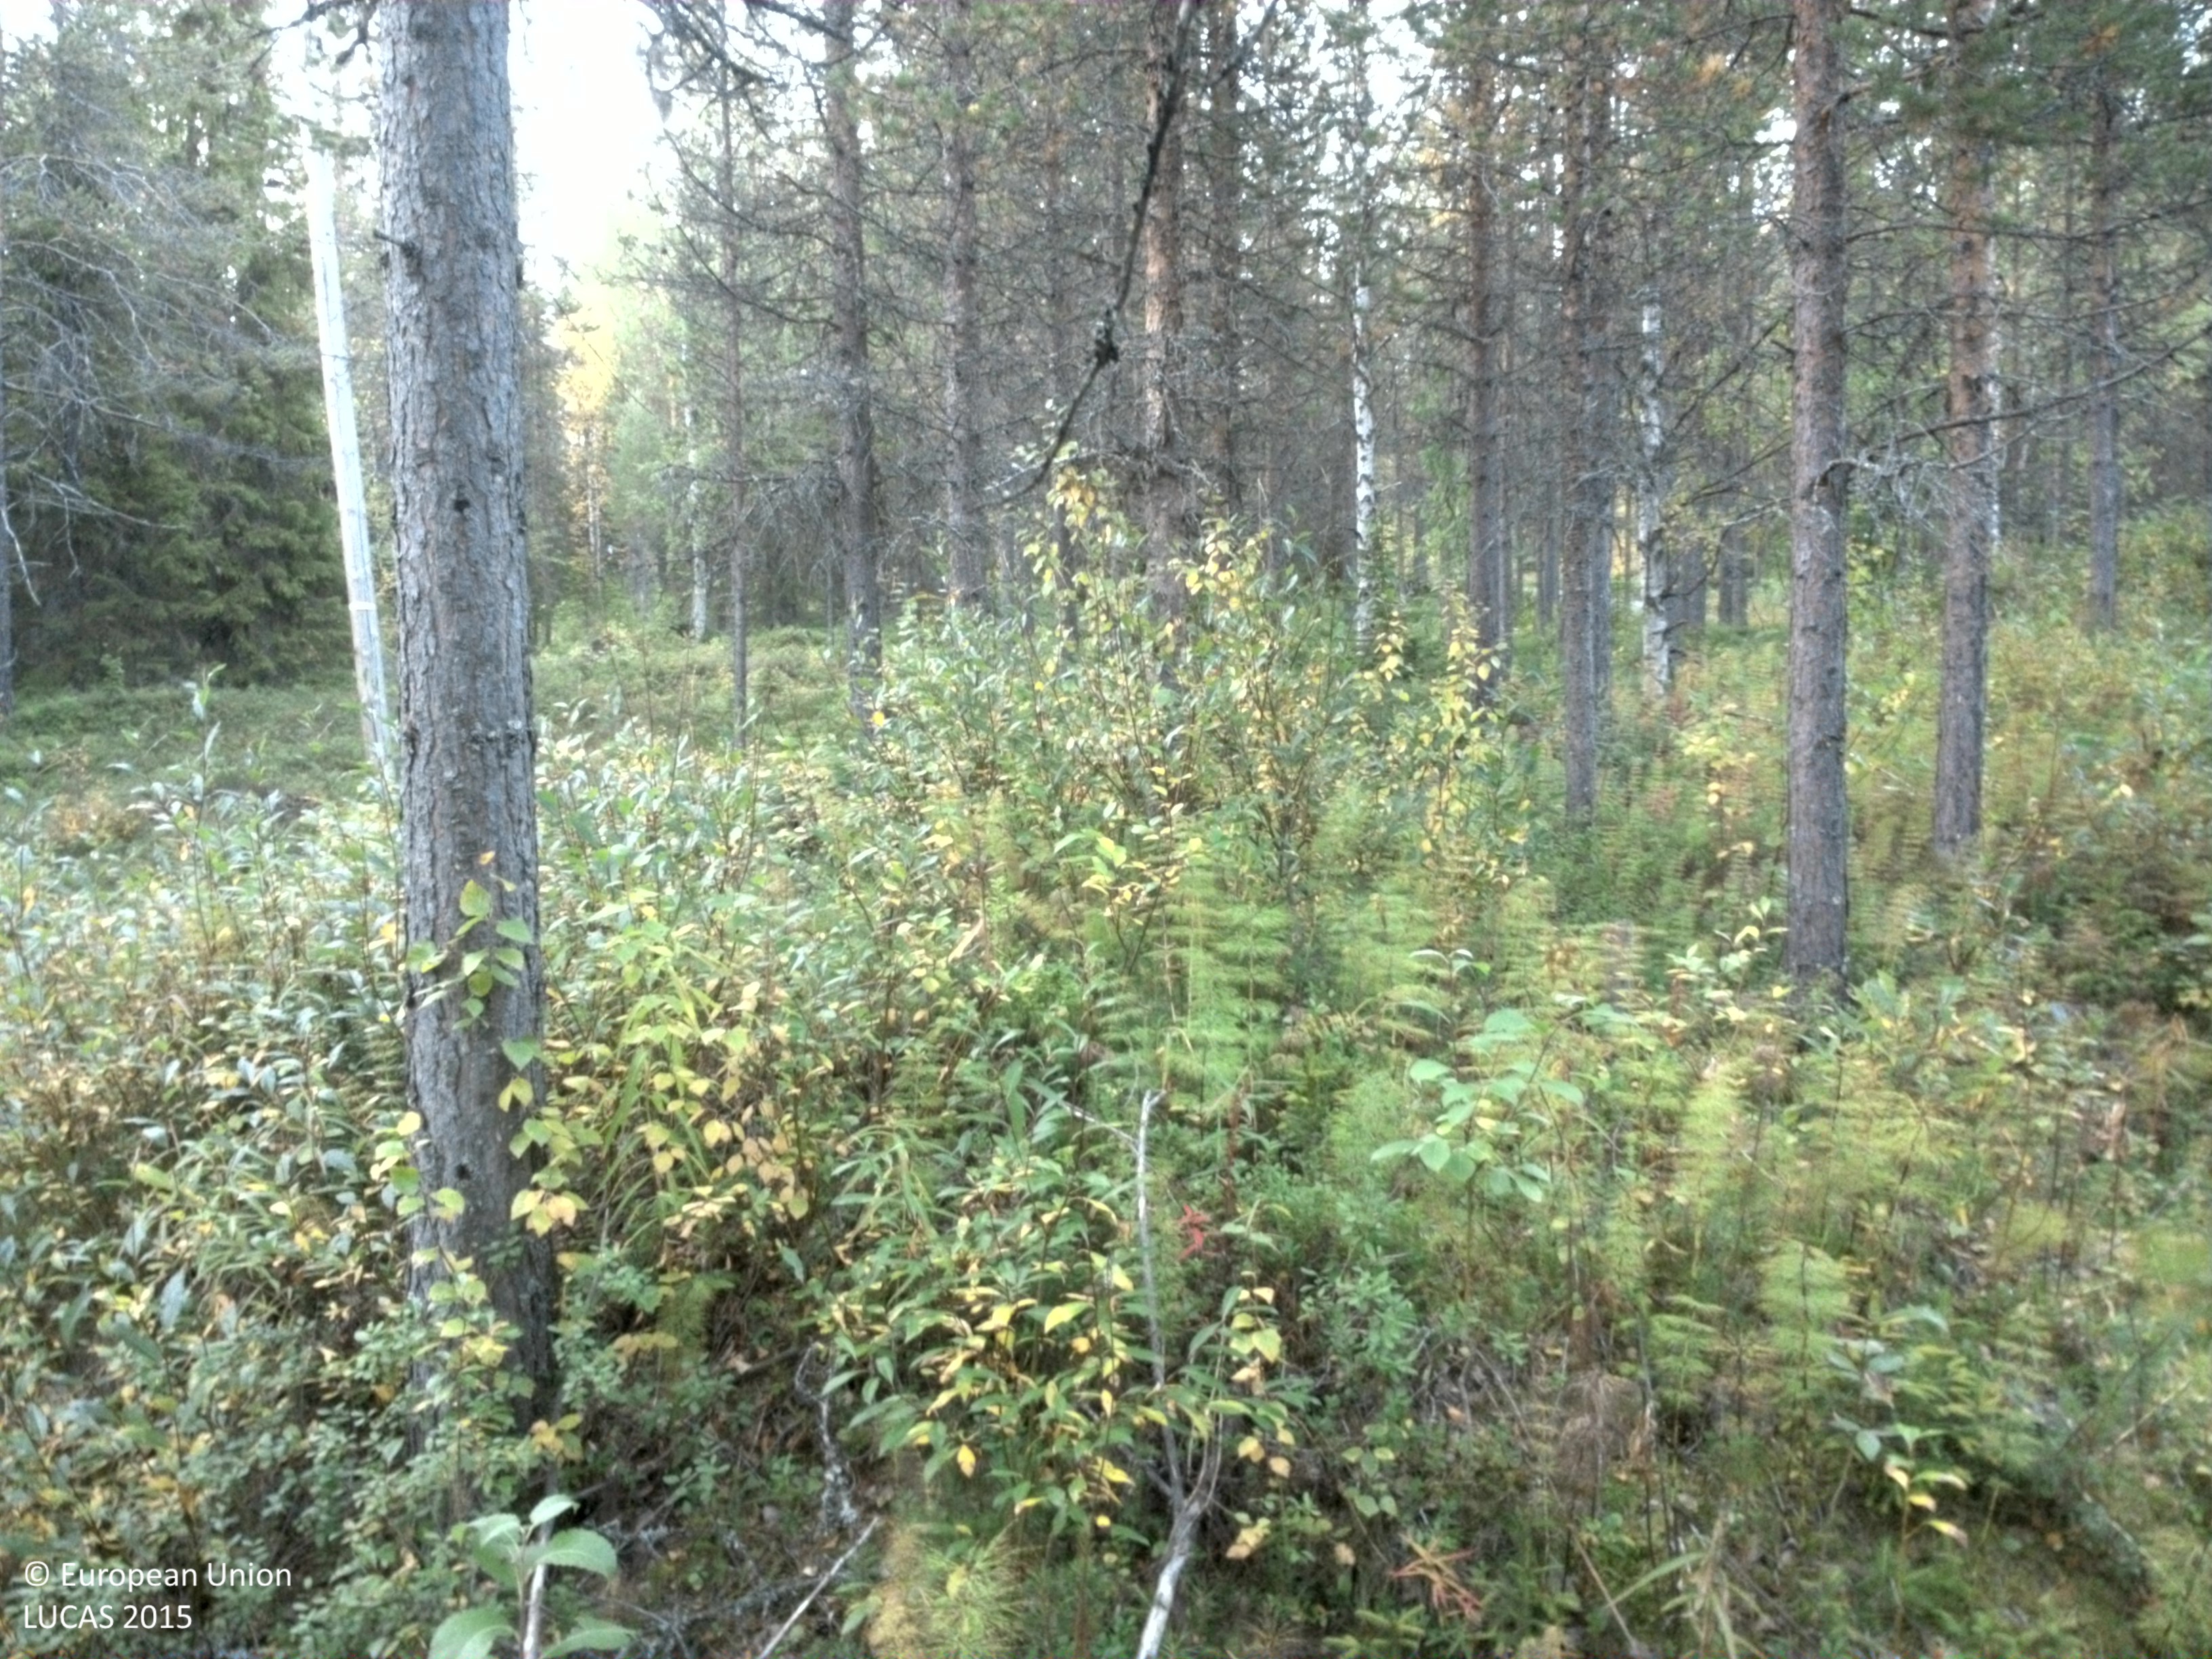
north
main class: Woodland
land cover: Pine dominated coniferous woodland
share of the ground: 25 - 50 %
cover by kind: shrubs 40 %, coniferous forest trees 30 %, herbaceous plants 20 %, broadleaved forest trees 5 %, lichens and mosses 5 %
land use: Forestry
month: September
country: SE
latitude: 65.2684
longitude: 16.7959
